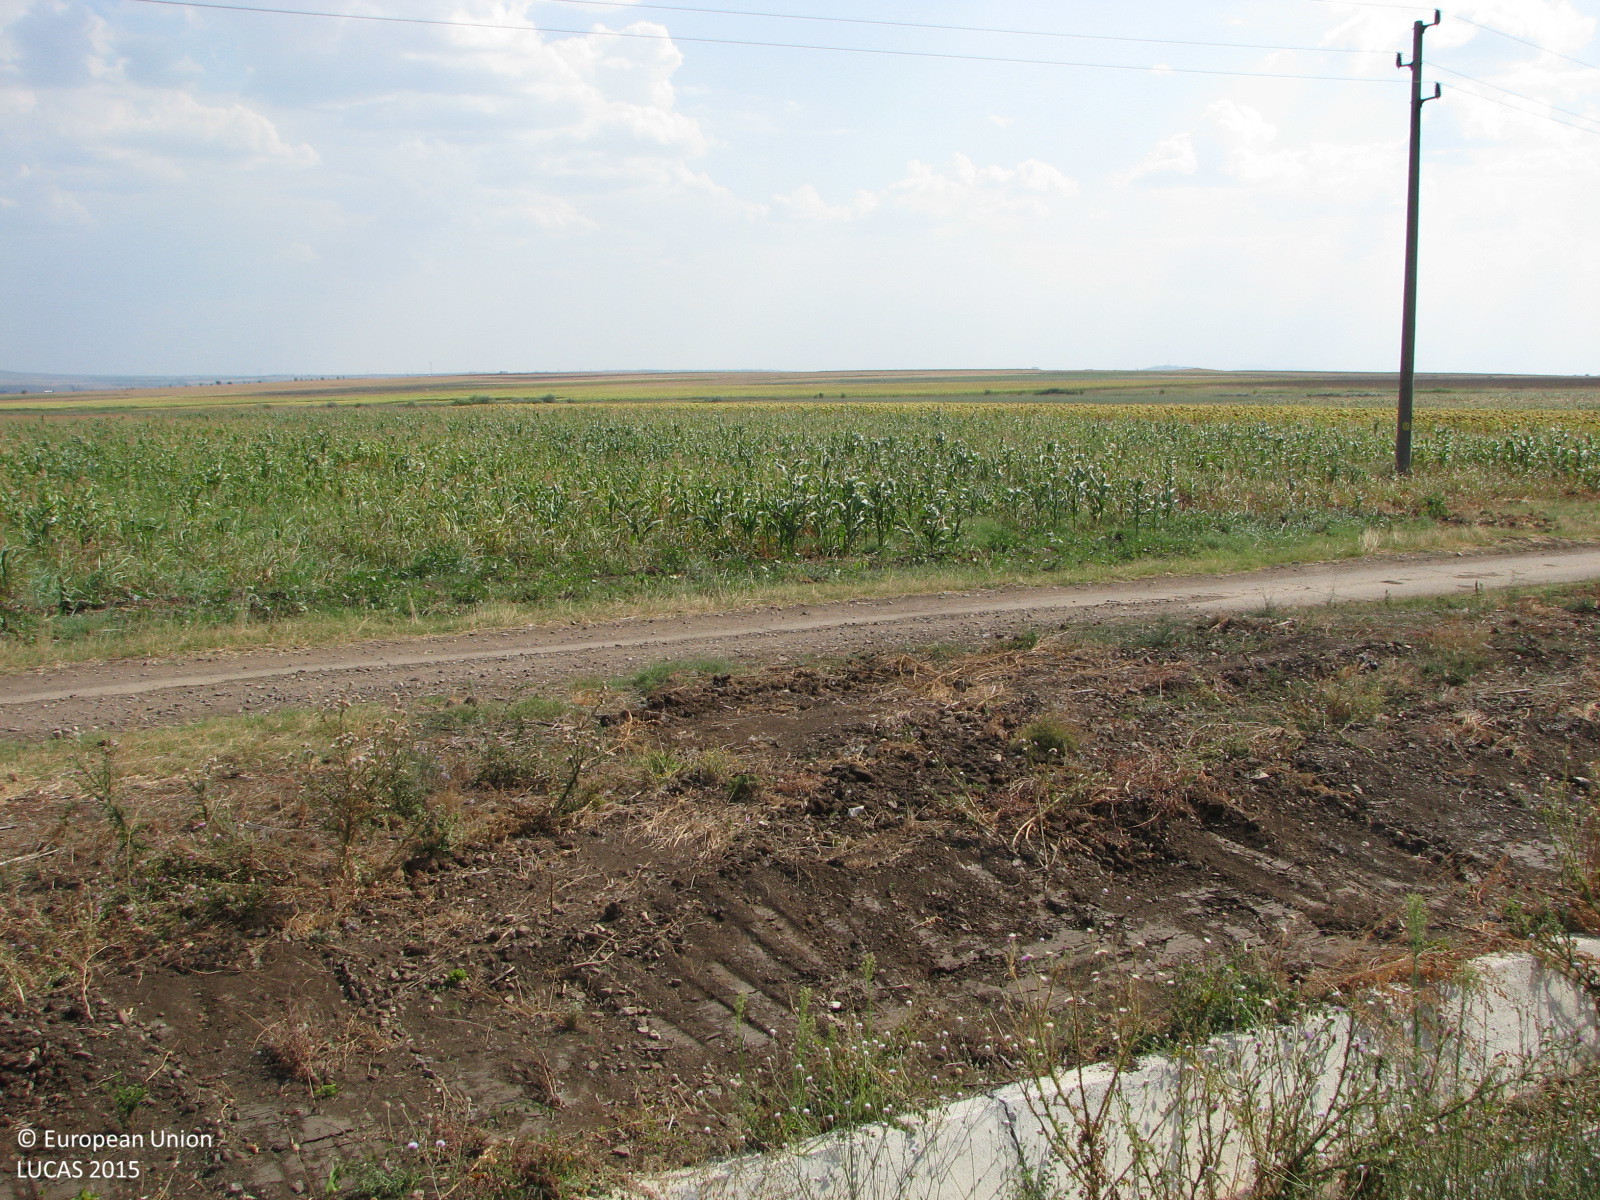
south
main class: Grassland
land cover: Spontaneously vegetated surfaces
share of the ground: > 75 %
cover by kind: herbaceous plants 100 %
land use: Railway transport
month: August
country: BG
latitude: 42.5823
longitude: 26.5810
